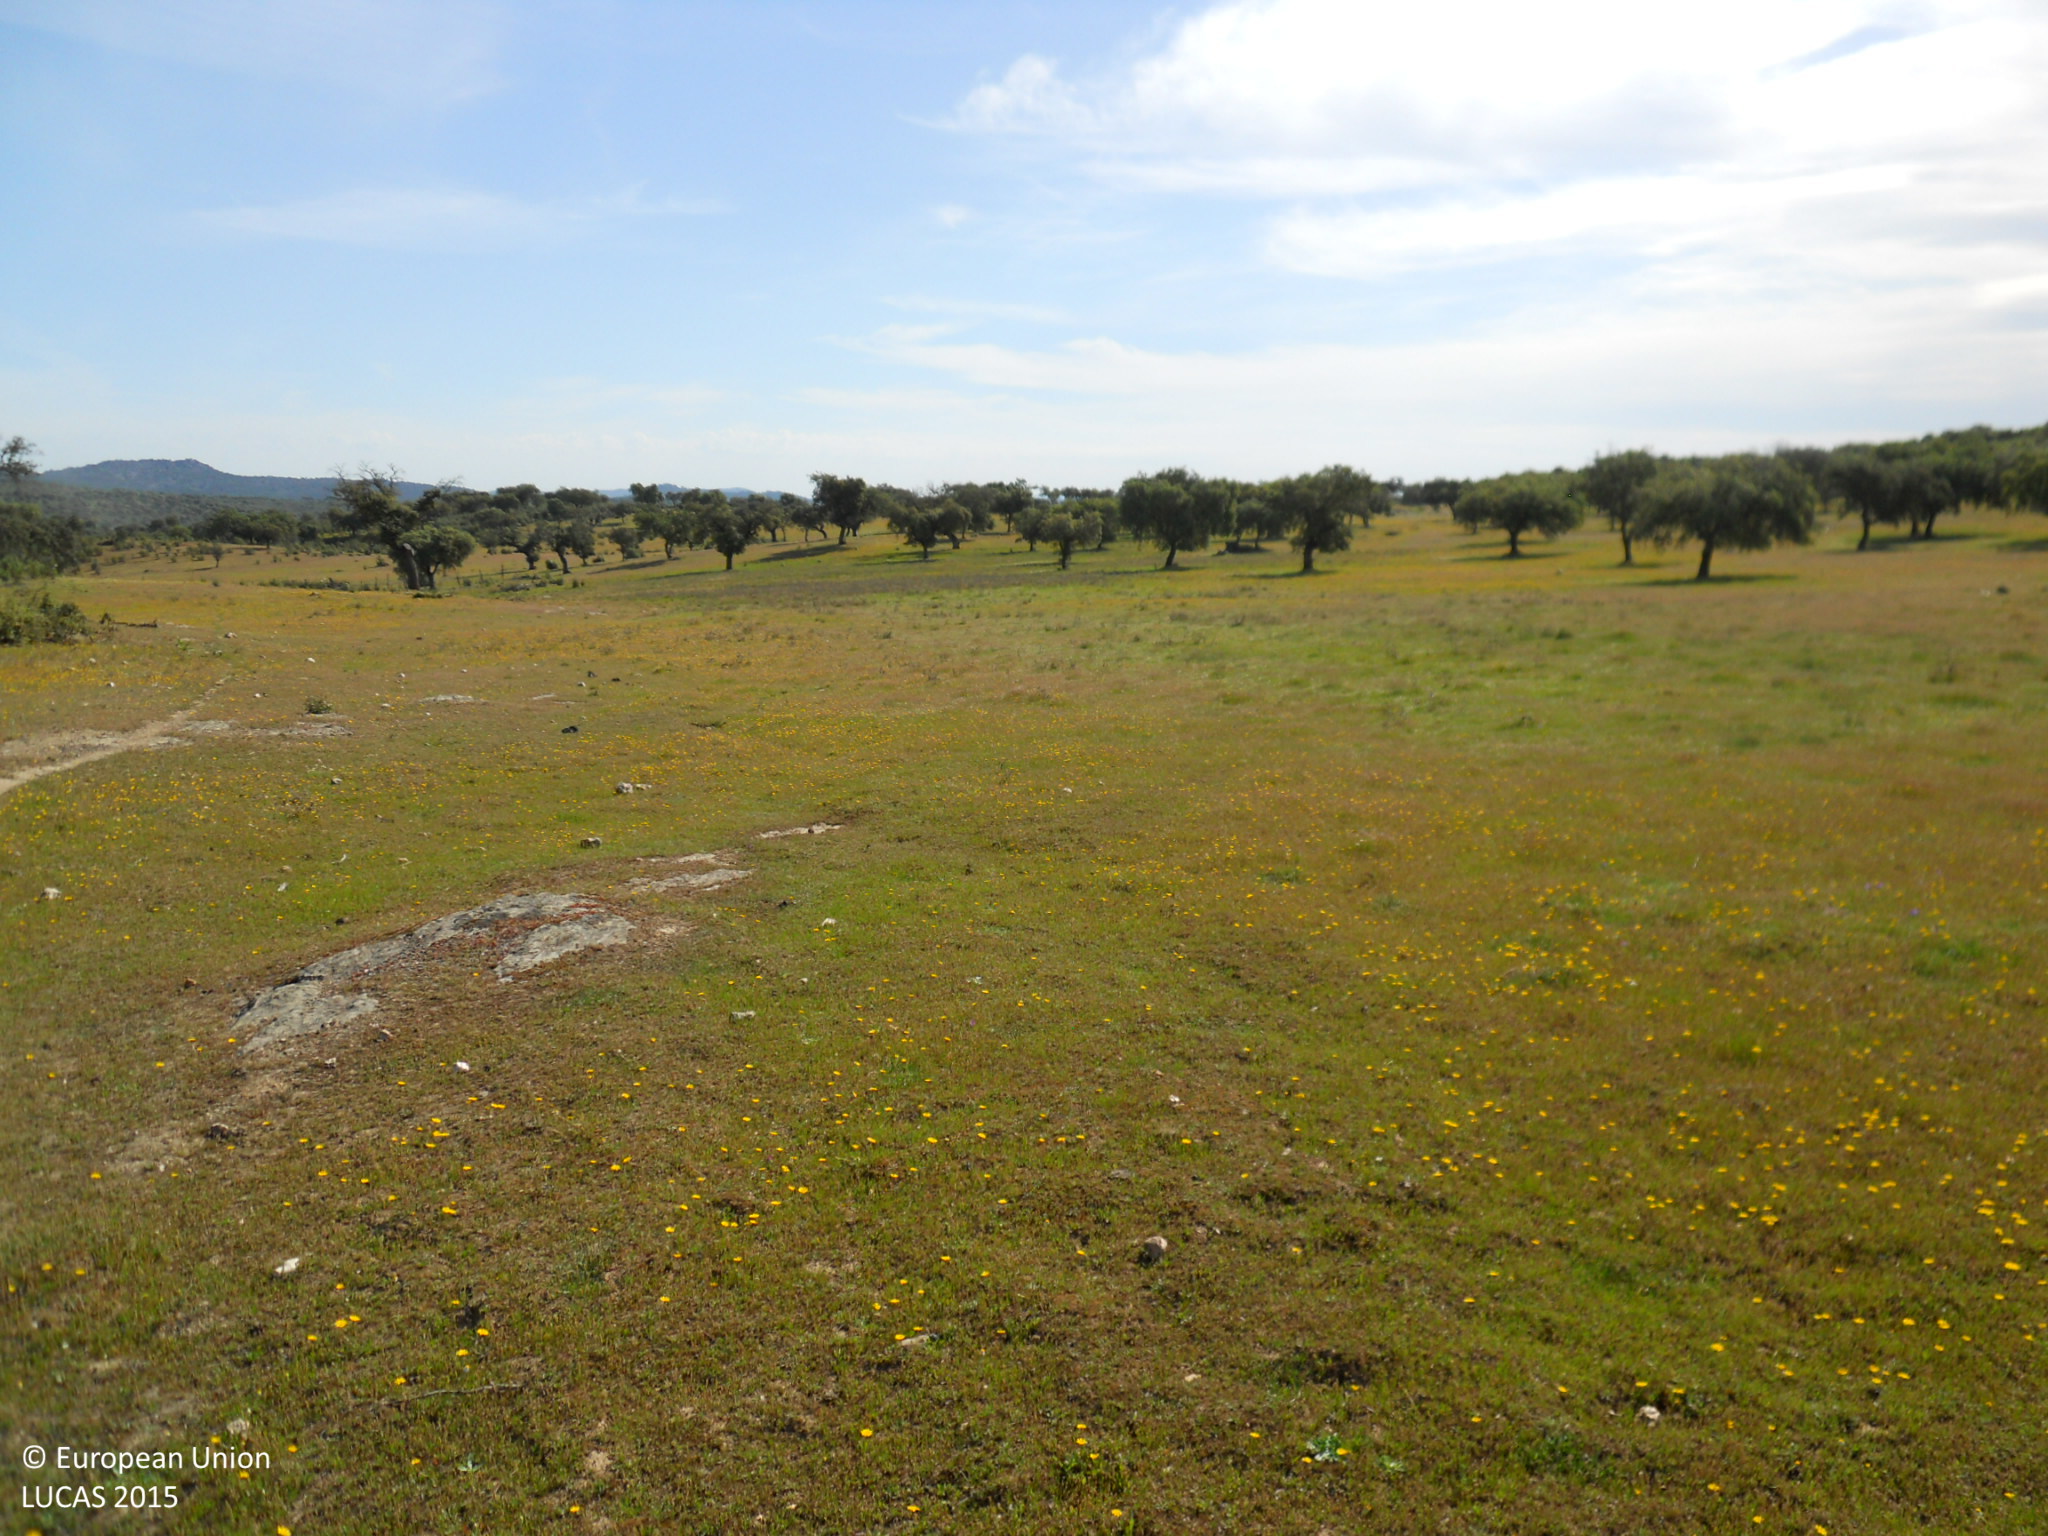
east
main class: Grassland
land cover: Grassland with sparse tree/shrub cover
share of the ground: > 75 %
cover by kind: herbaceous plants 95 %, broadleaved forest trees 5 %
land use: Agriculture (excluding fallow land and kitchen gardens)
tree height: > 5 m
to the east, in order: Grassland with sparse tree/shrub cover; Broadleaved woodland; Grassland with sparse tree/shrub cover; Grassland without tree/shrub cover; Broadleaved woodland; Grassland with sparse tree/shrub cover; Broadleaved woodland
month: April
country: ES
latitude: 39.1913
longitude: -6.9203
